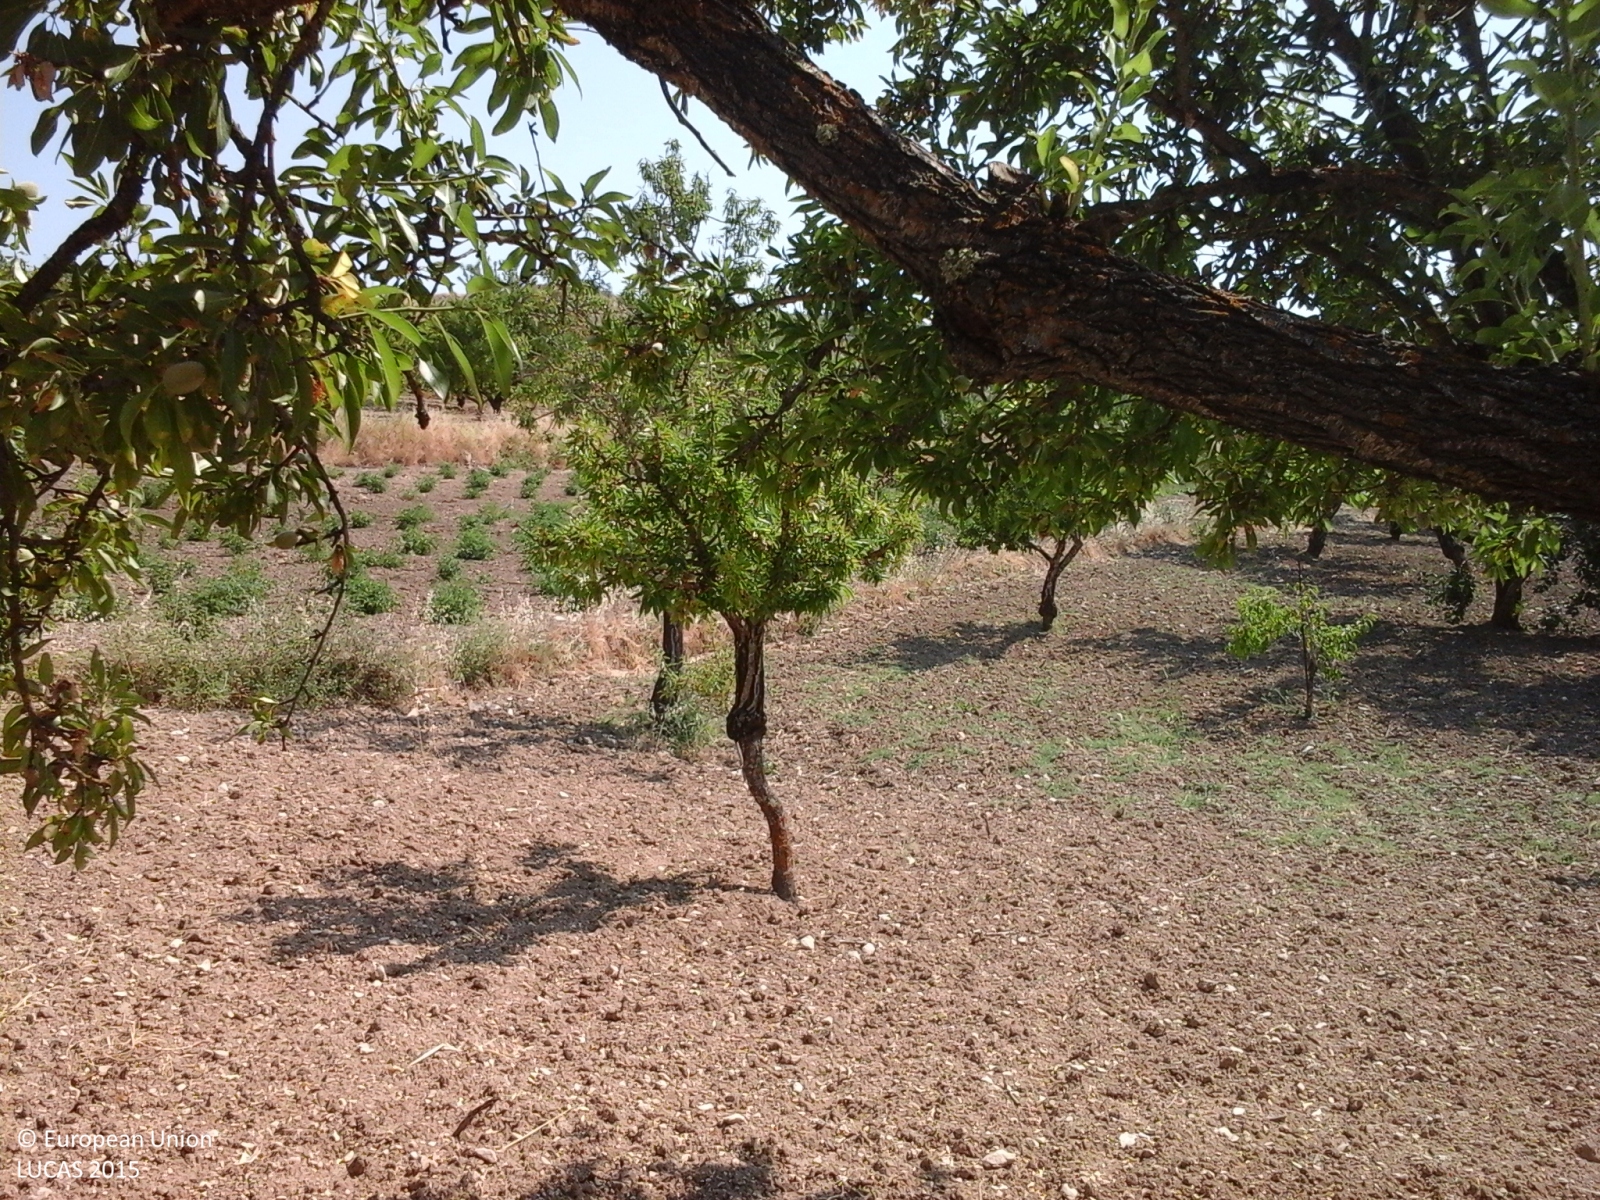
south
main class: Cropland
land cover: Nuts trees
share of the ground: 50 - 75 %
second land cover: Other bare soil
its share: > 75 %
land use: Agriculture (excluding fallow land and kitchen gardens)
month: July
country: IT
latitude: 37.4440
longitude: 13.5783
